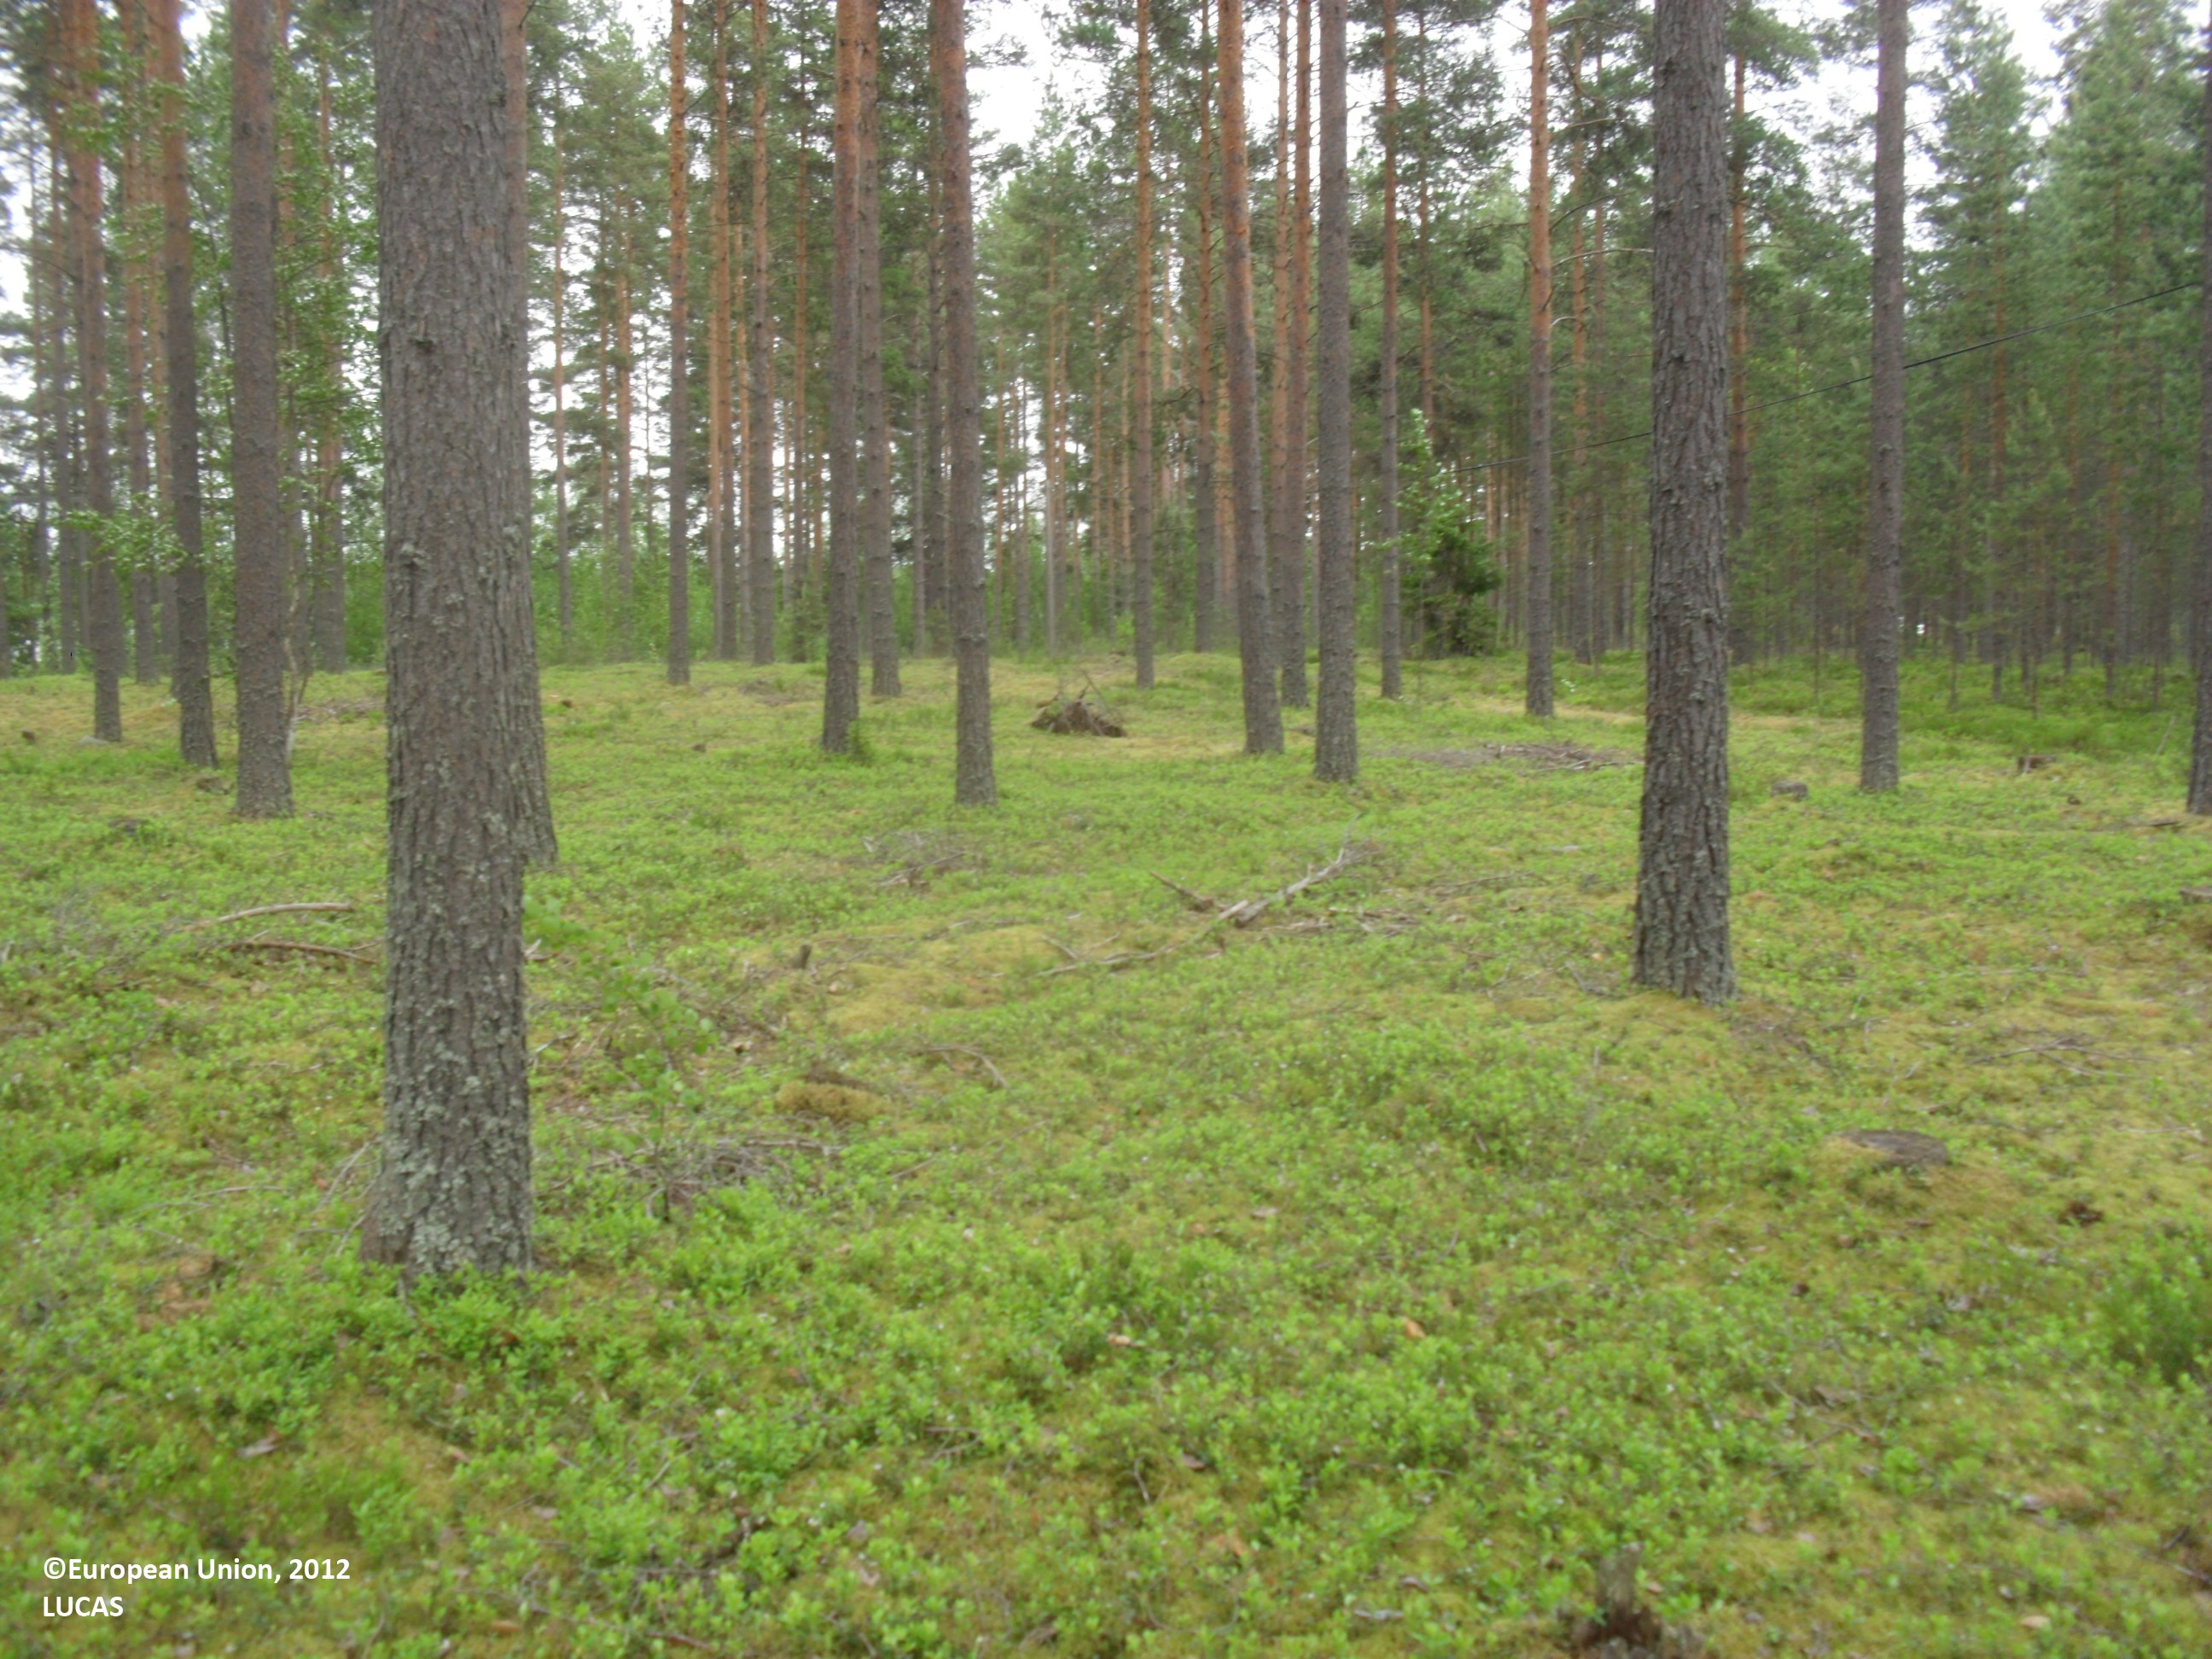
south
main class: Woodland
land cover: Pine dominated coniferous woodland
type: boreal forest
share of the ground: 25 - 50 %
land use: Forestry
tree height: > 5 m
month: June
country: FI
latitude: 62.9521
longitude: 23.5305
